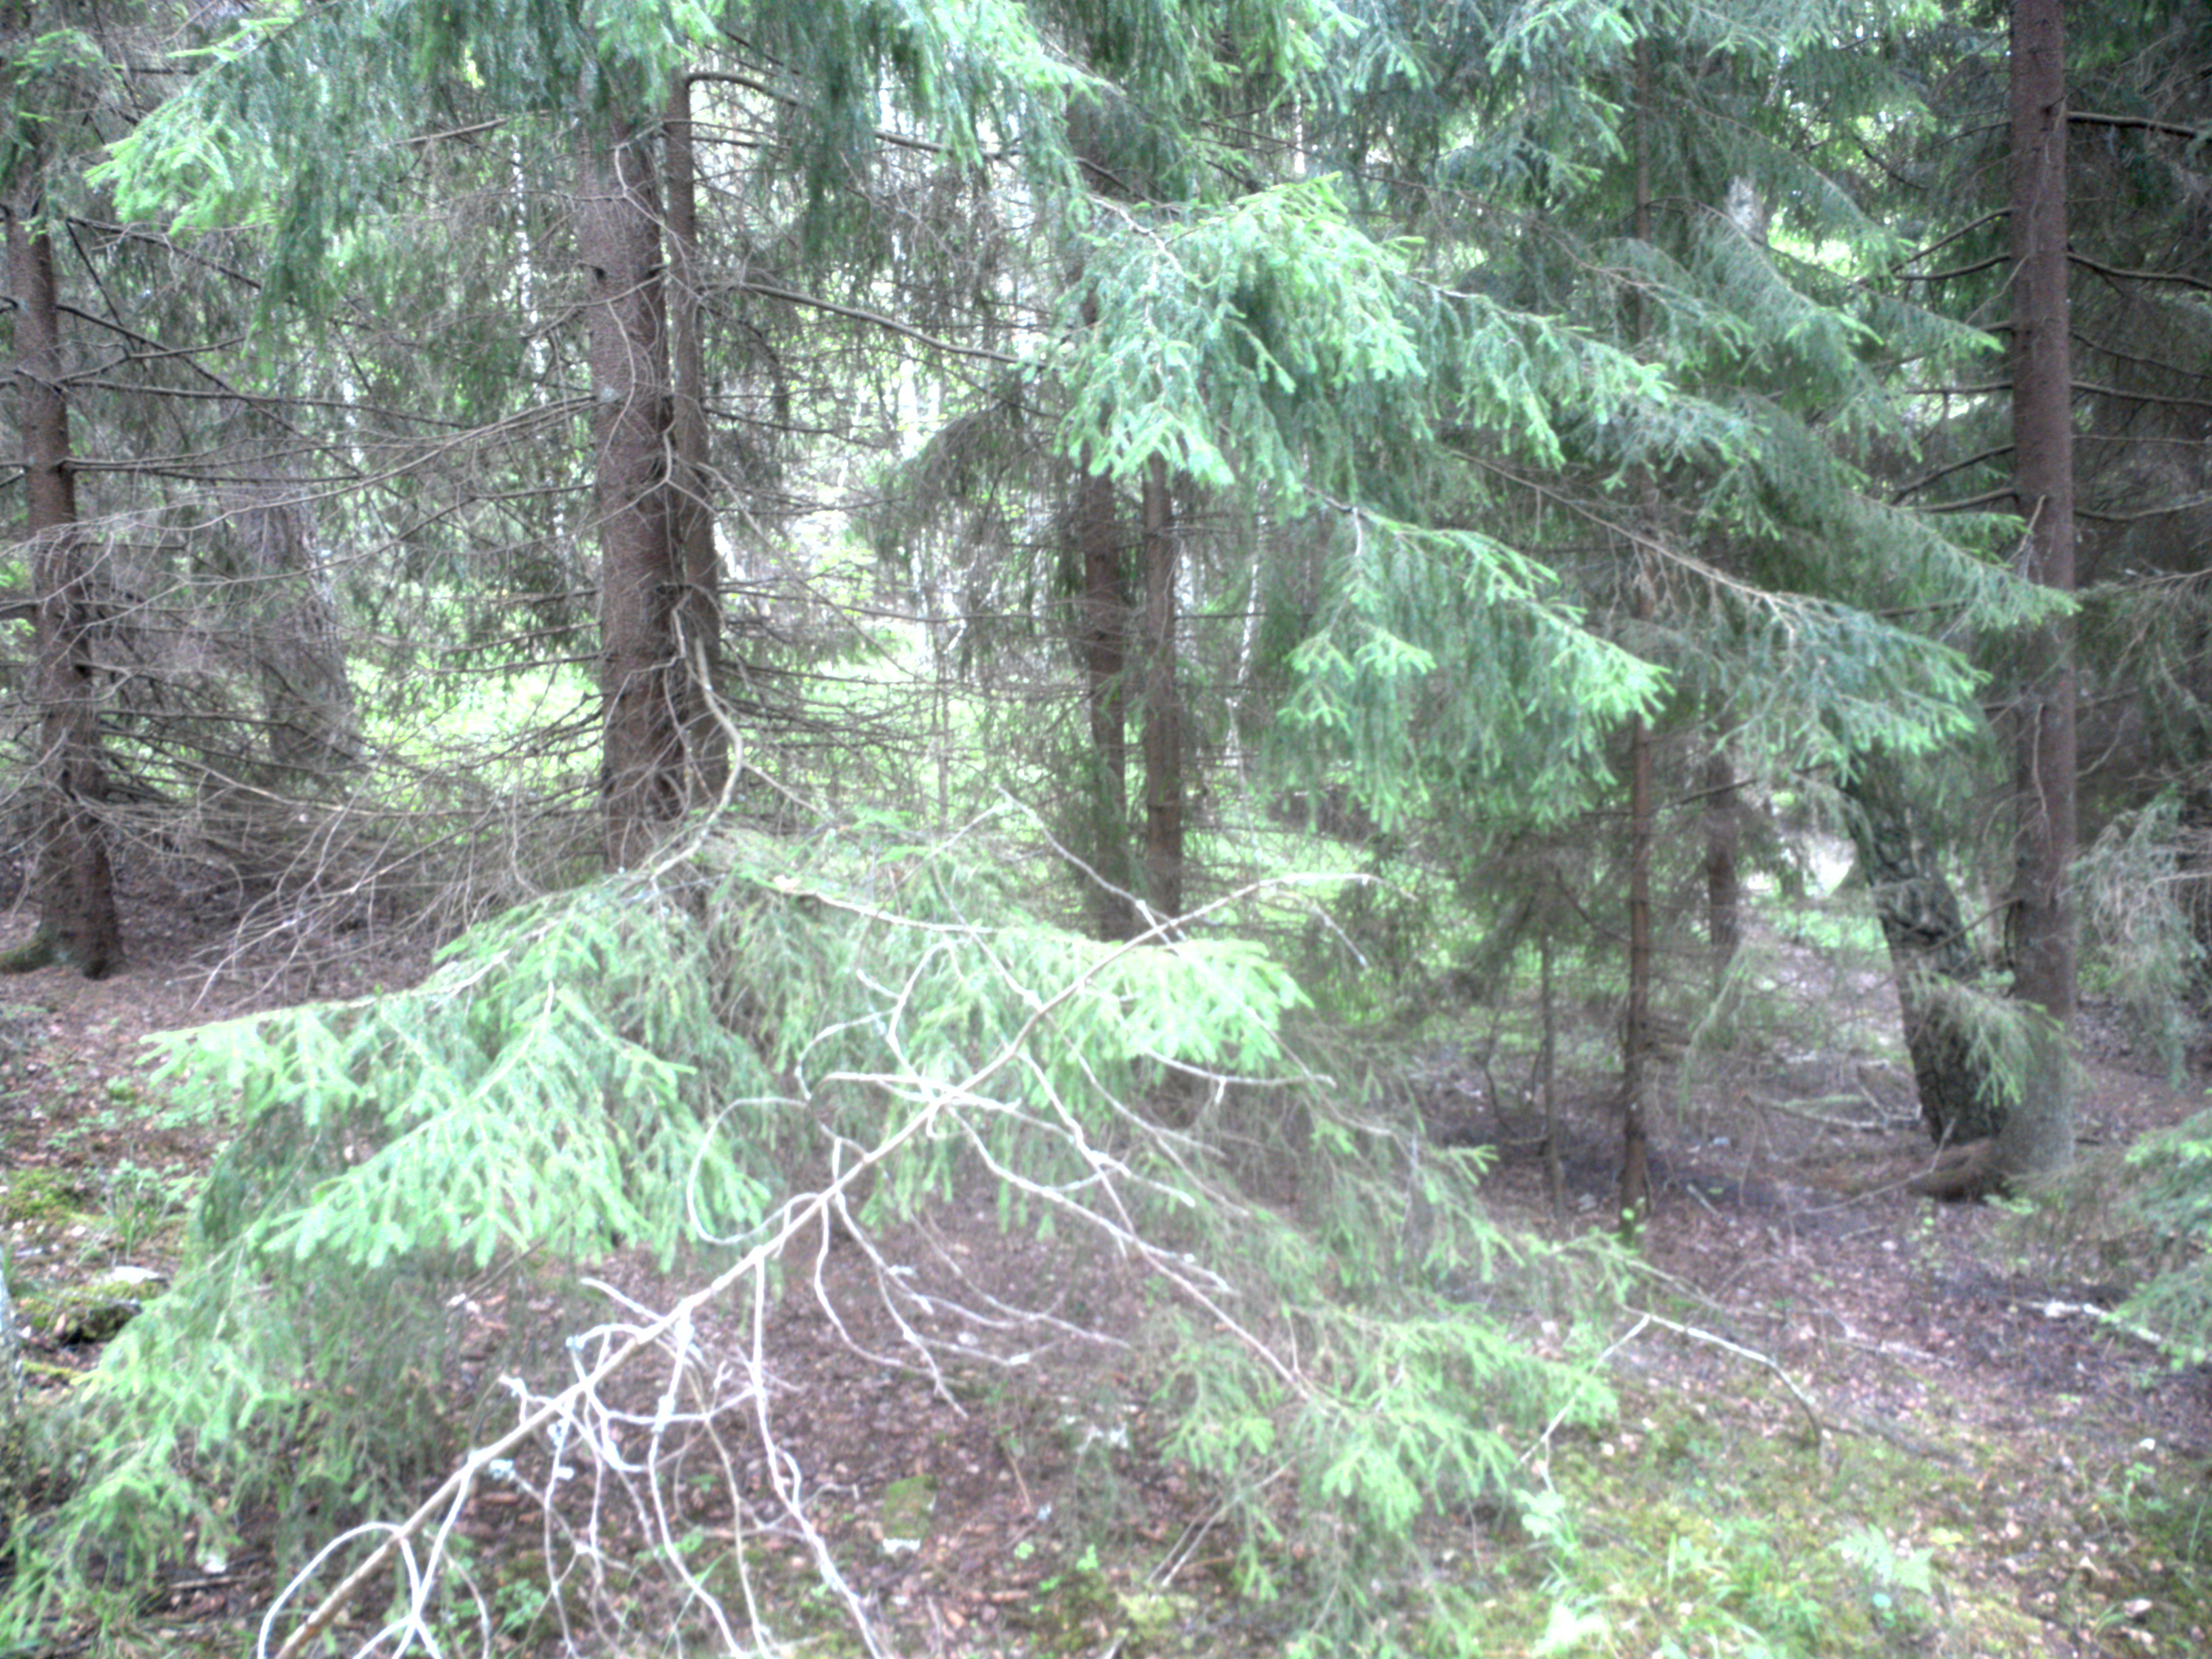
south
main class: Woodland
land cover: Spruce dominated mixed woodland
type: boreal forest
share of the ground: 50 - 75 %
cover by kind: coniferous forest trees 50 %, broadleaved forest trees 20 %, lichens and mosses 20 %, herbaceous plants 10 %
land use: Forestry
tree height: > 5 m
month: June
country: SE
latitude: 59.4215
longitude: 17.8042
